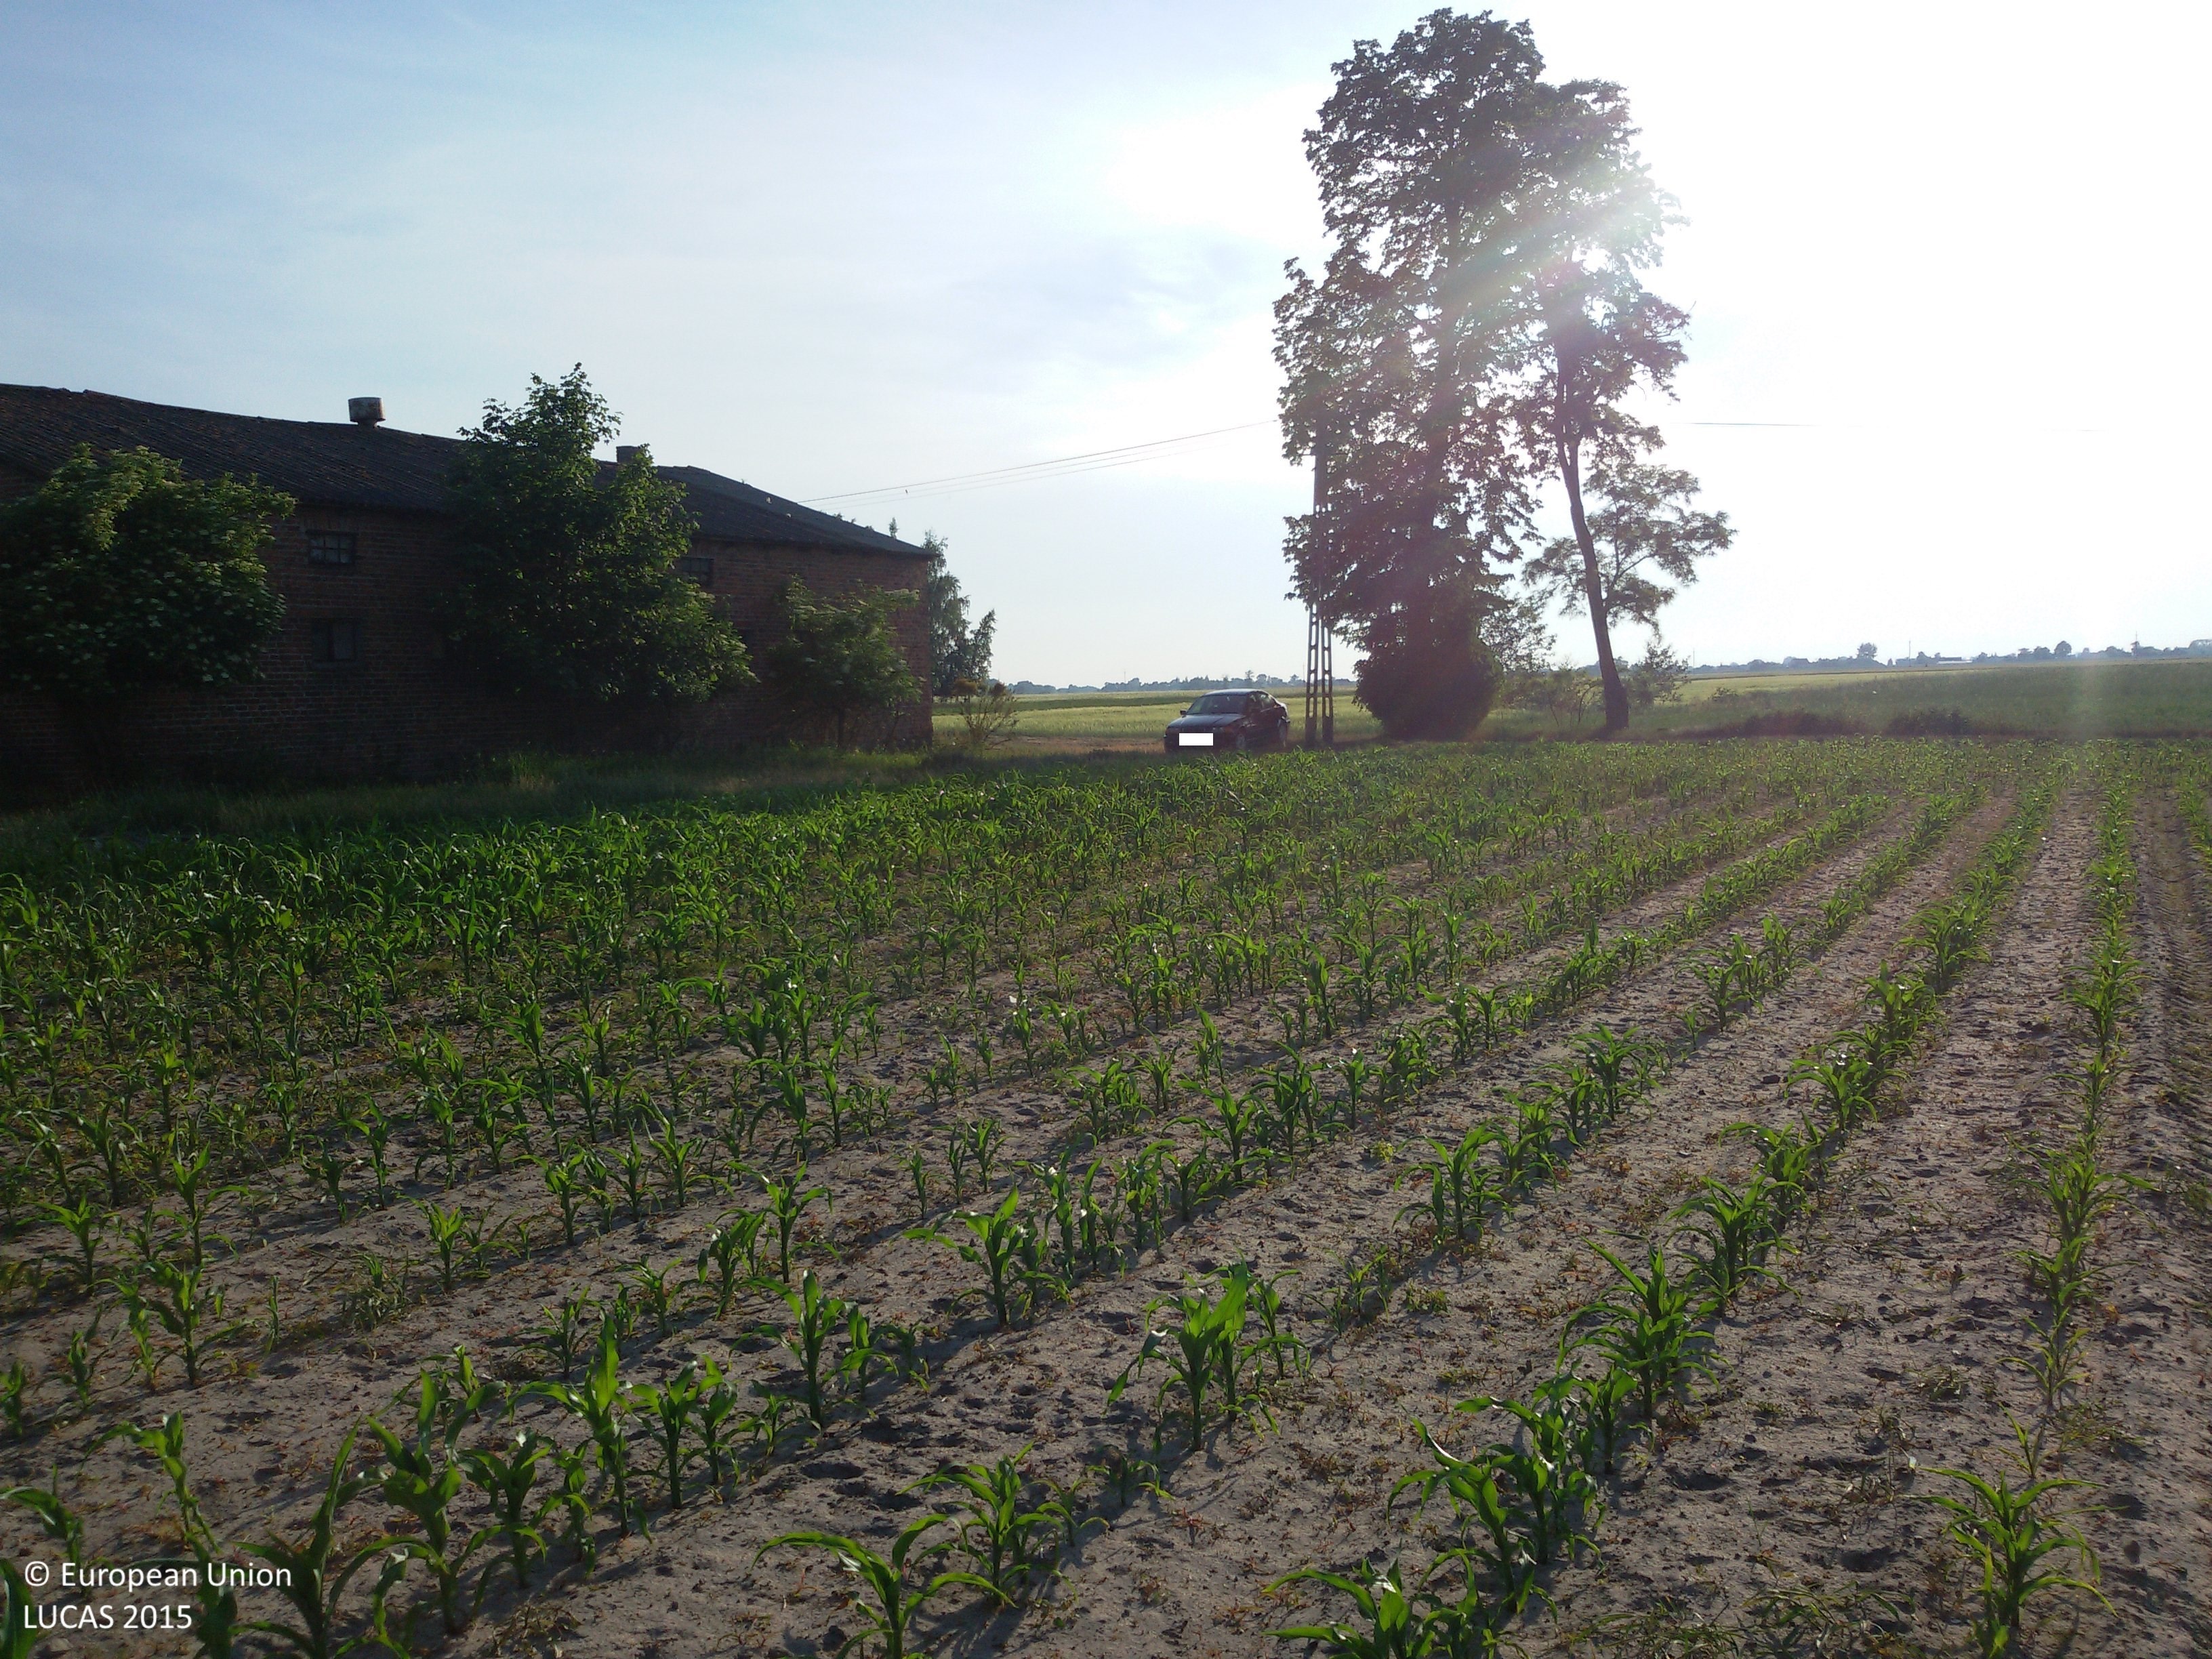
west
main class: Cropland
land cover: Maize
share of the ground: 25 - 50 %
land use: Agriculture (excluding fallow land and kitchen gardens)
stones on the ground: < 10 %
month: June
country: PL
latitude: 52.5036
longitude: 19.0245
